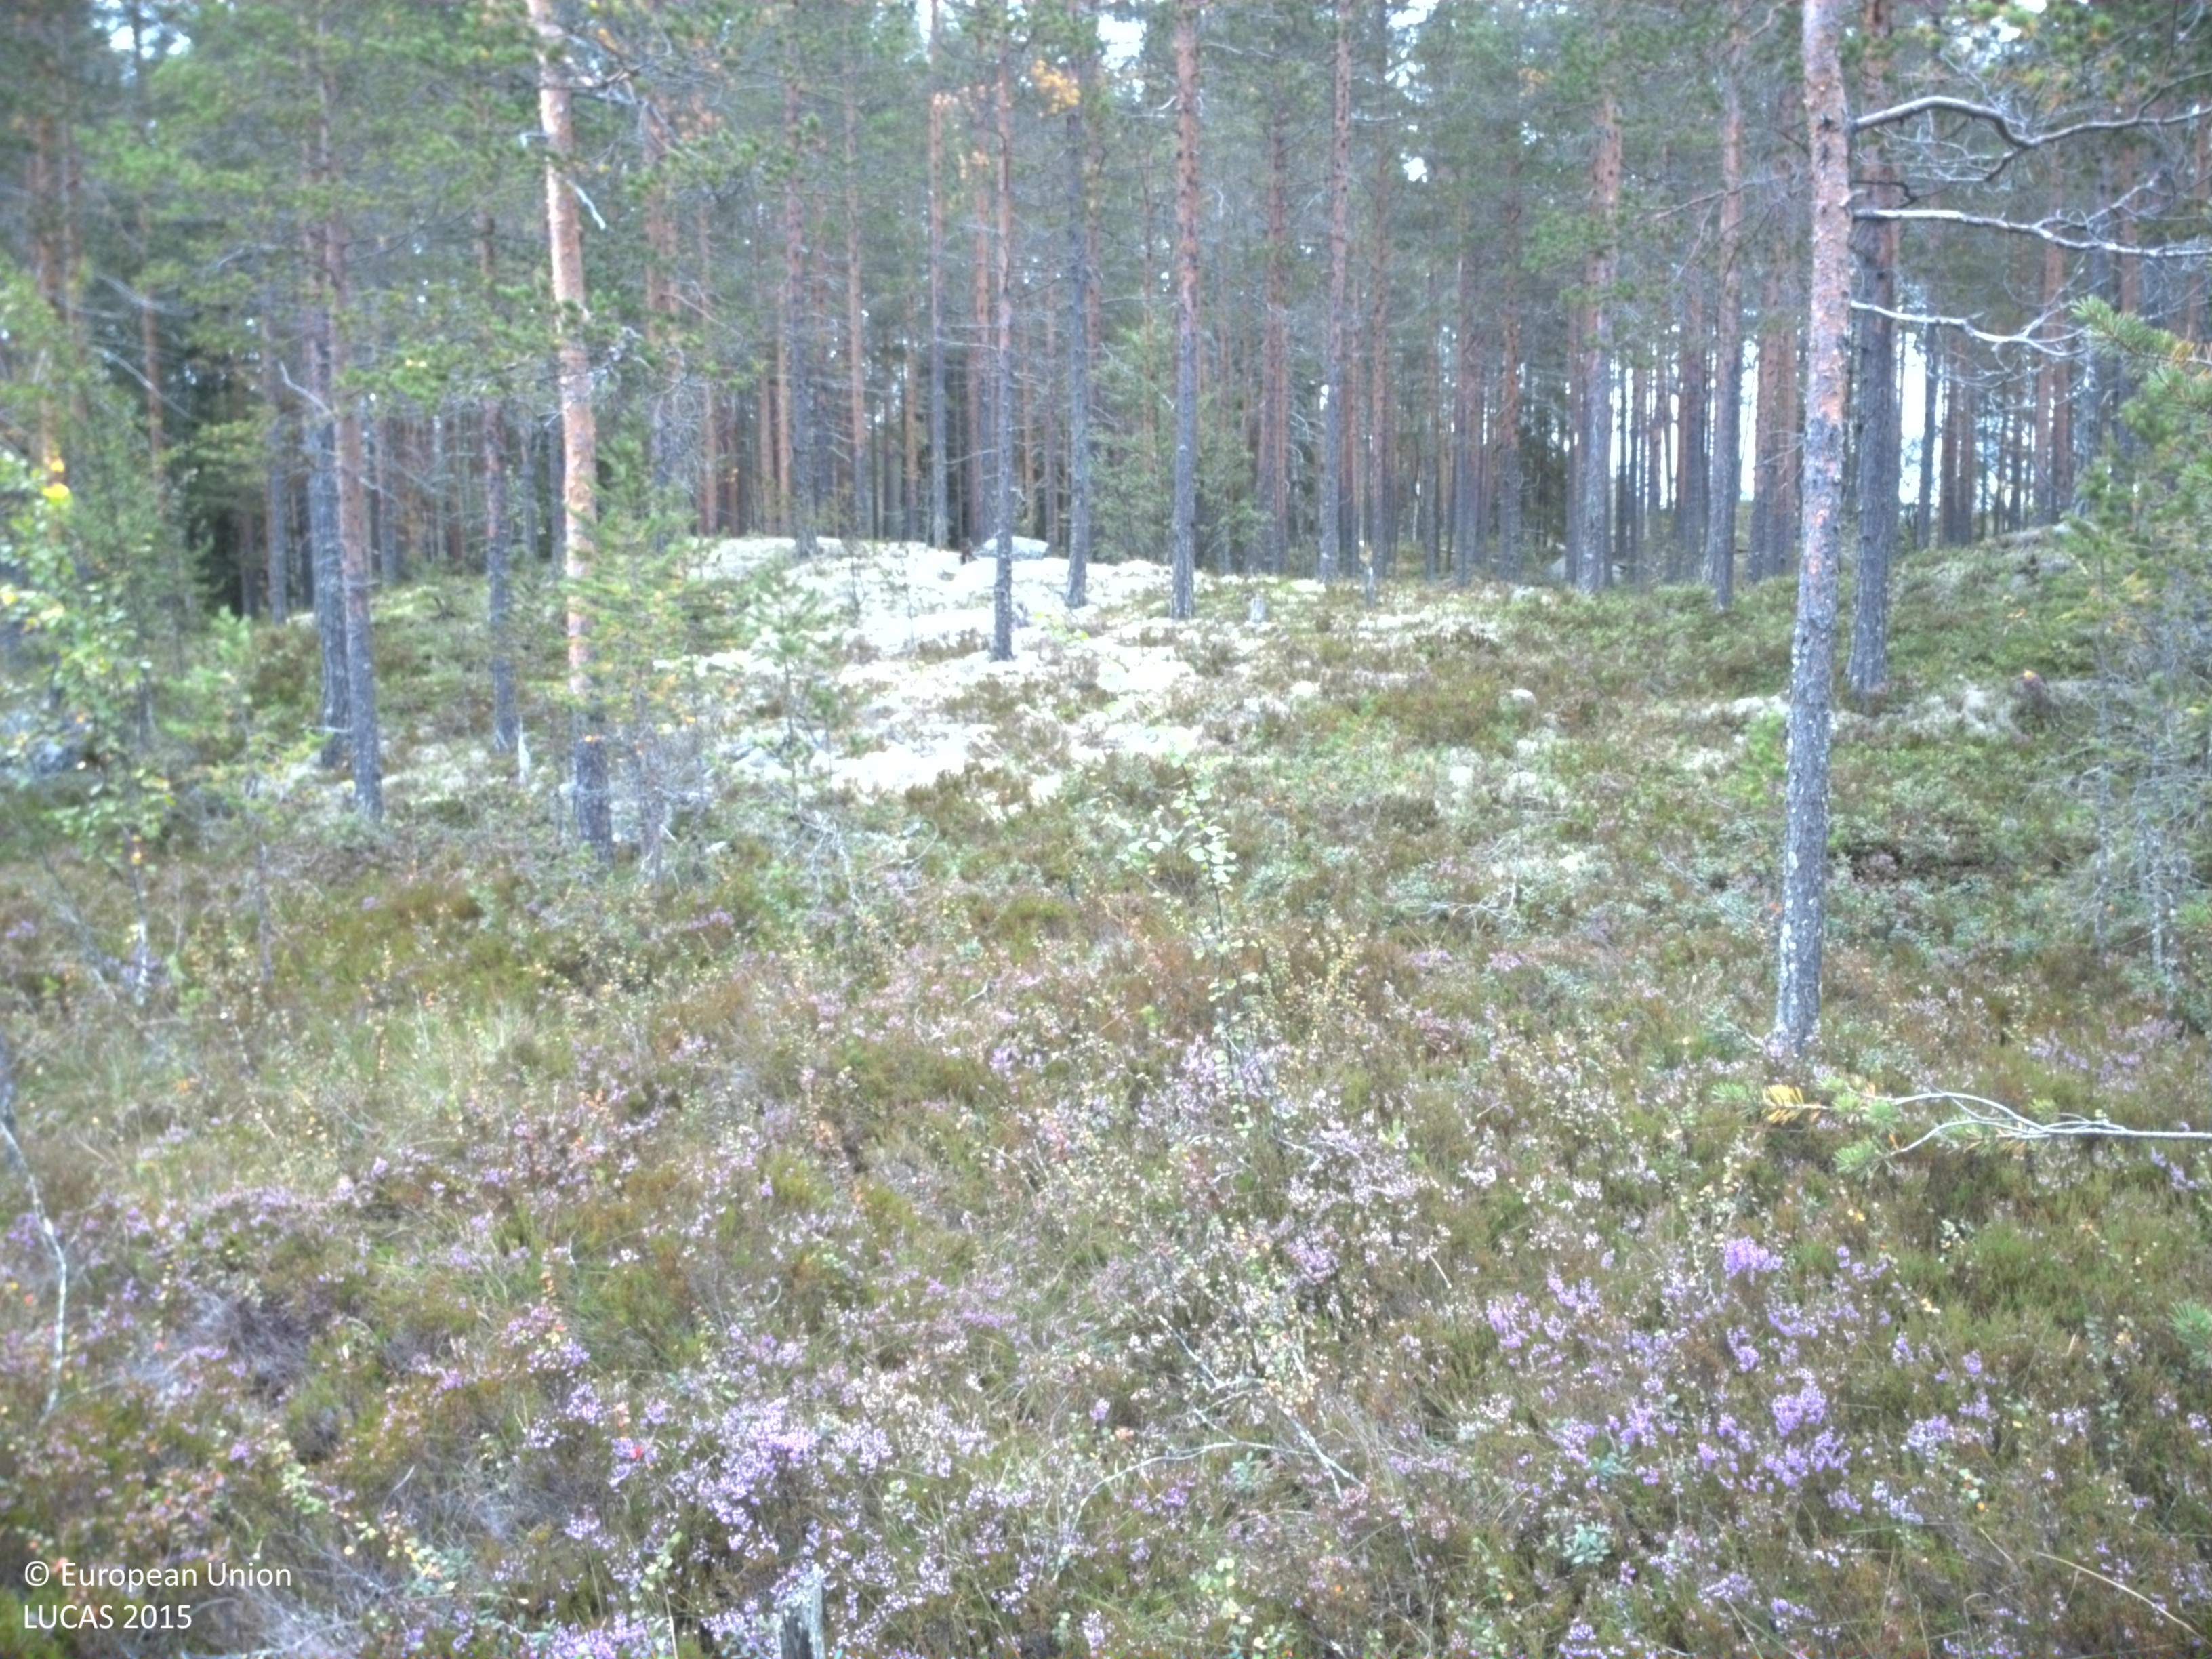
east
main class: Woodland
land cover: Pine dominated coniferous woodland
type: boreal forest
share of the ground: 25 - 50 %
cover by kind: coniferous forest trees 40 %, shrubs 40 %, lichens and mosses 15 %, broadleaved forest trees 5 %
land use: Forestry
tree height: > 5 m
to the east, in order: Pine dominated coniferous woodland; Shrubland with sparse tree cover
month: August
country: SE
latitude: 61.6961
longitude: 15.0692
